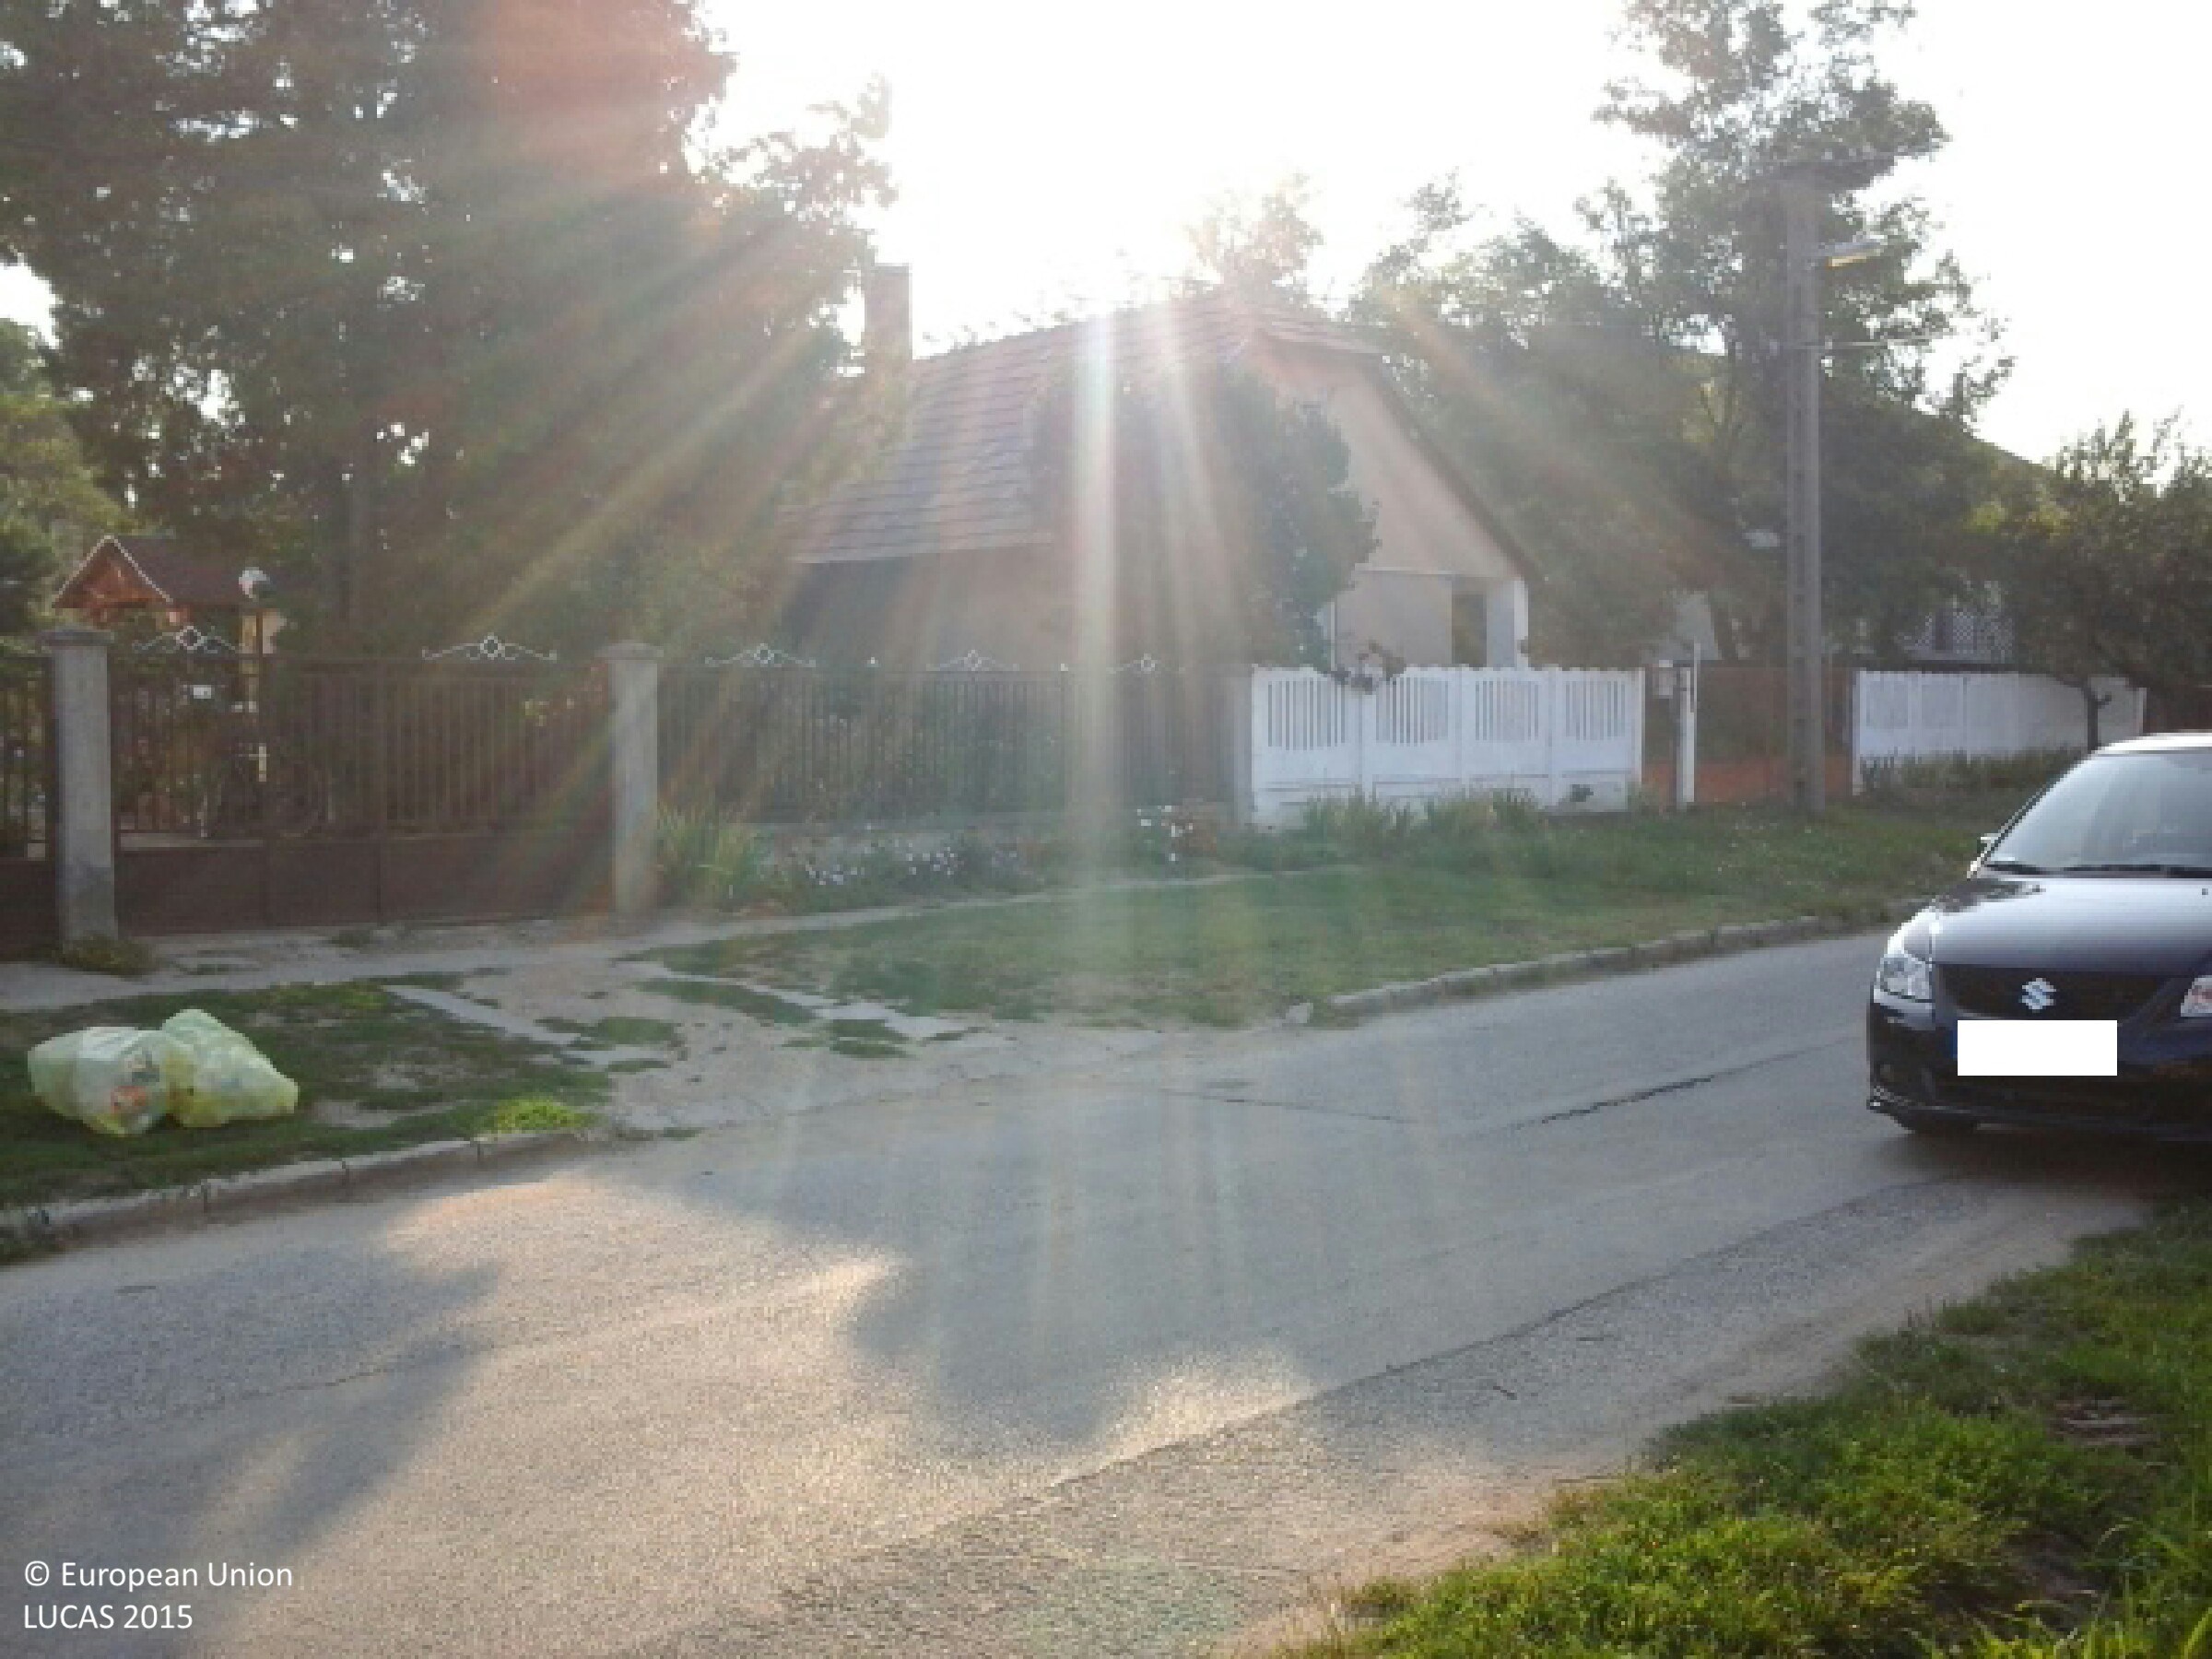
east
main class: Grassland
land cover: Grassland without tree/shrub cover
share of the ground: > 75 %
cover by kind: herbaceous plants 95 %, shrubs 5 %
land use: Residential
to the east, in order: Grassland without tree/shrub cover; Artificial constructions in urban areas
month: August
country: HU
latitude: 47.2806
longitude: 18.4873
